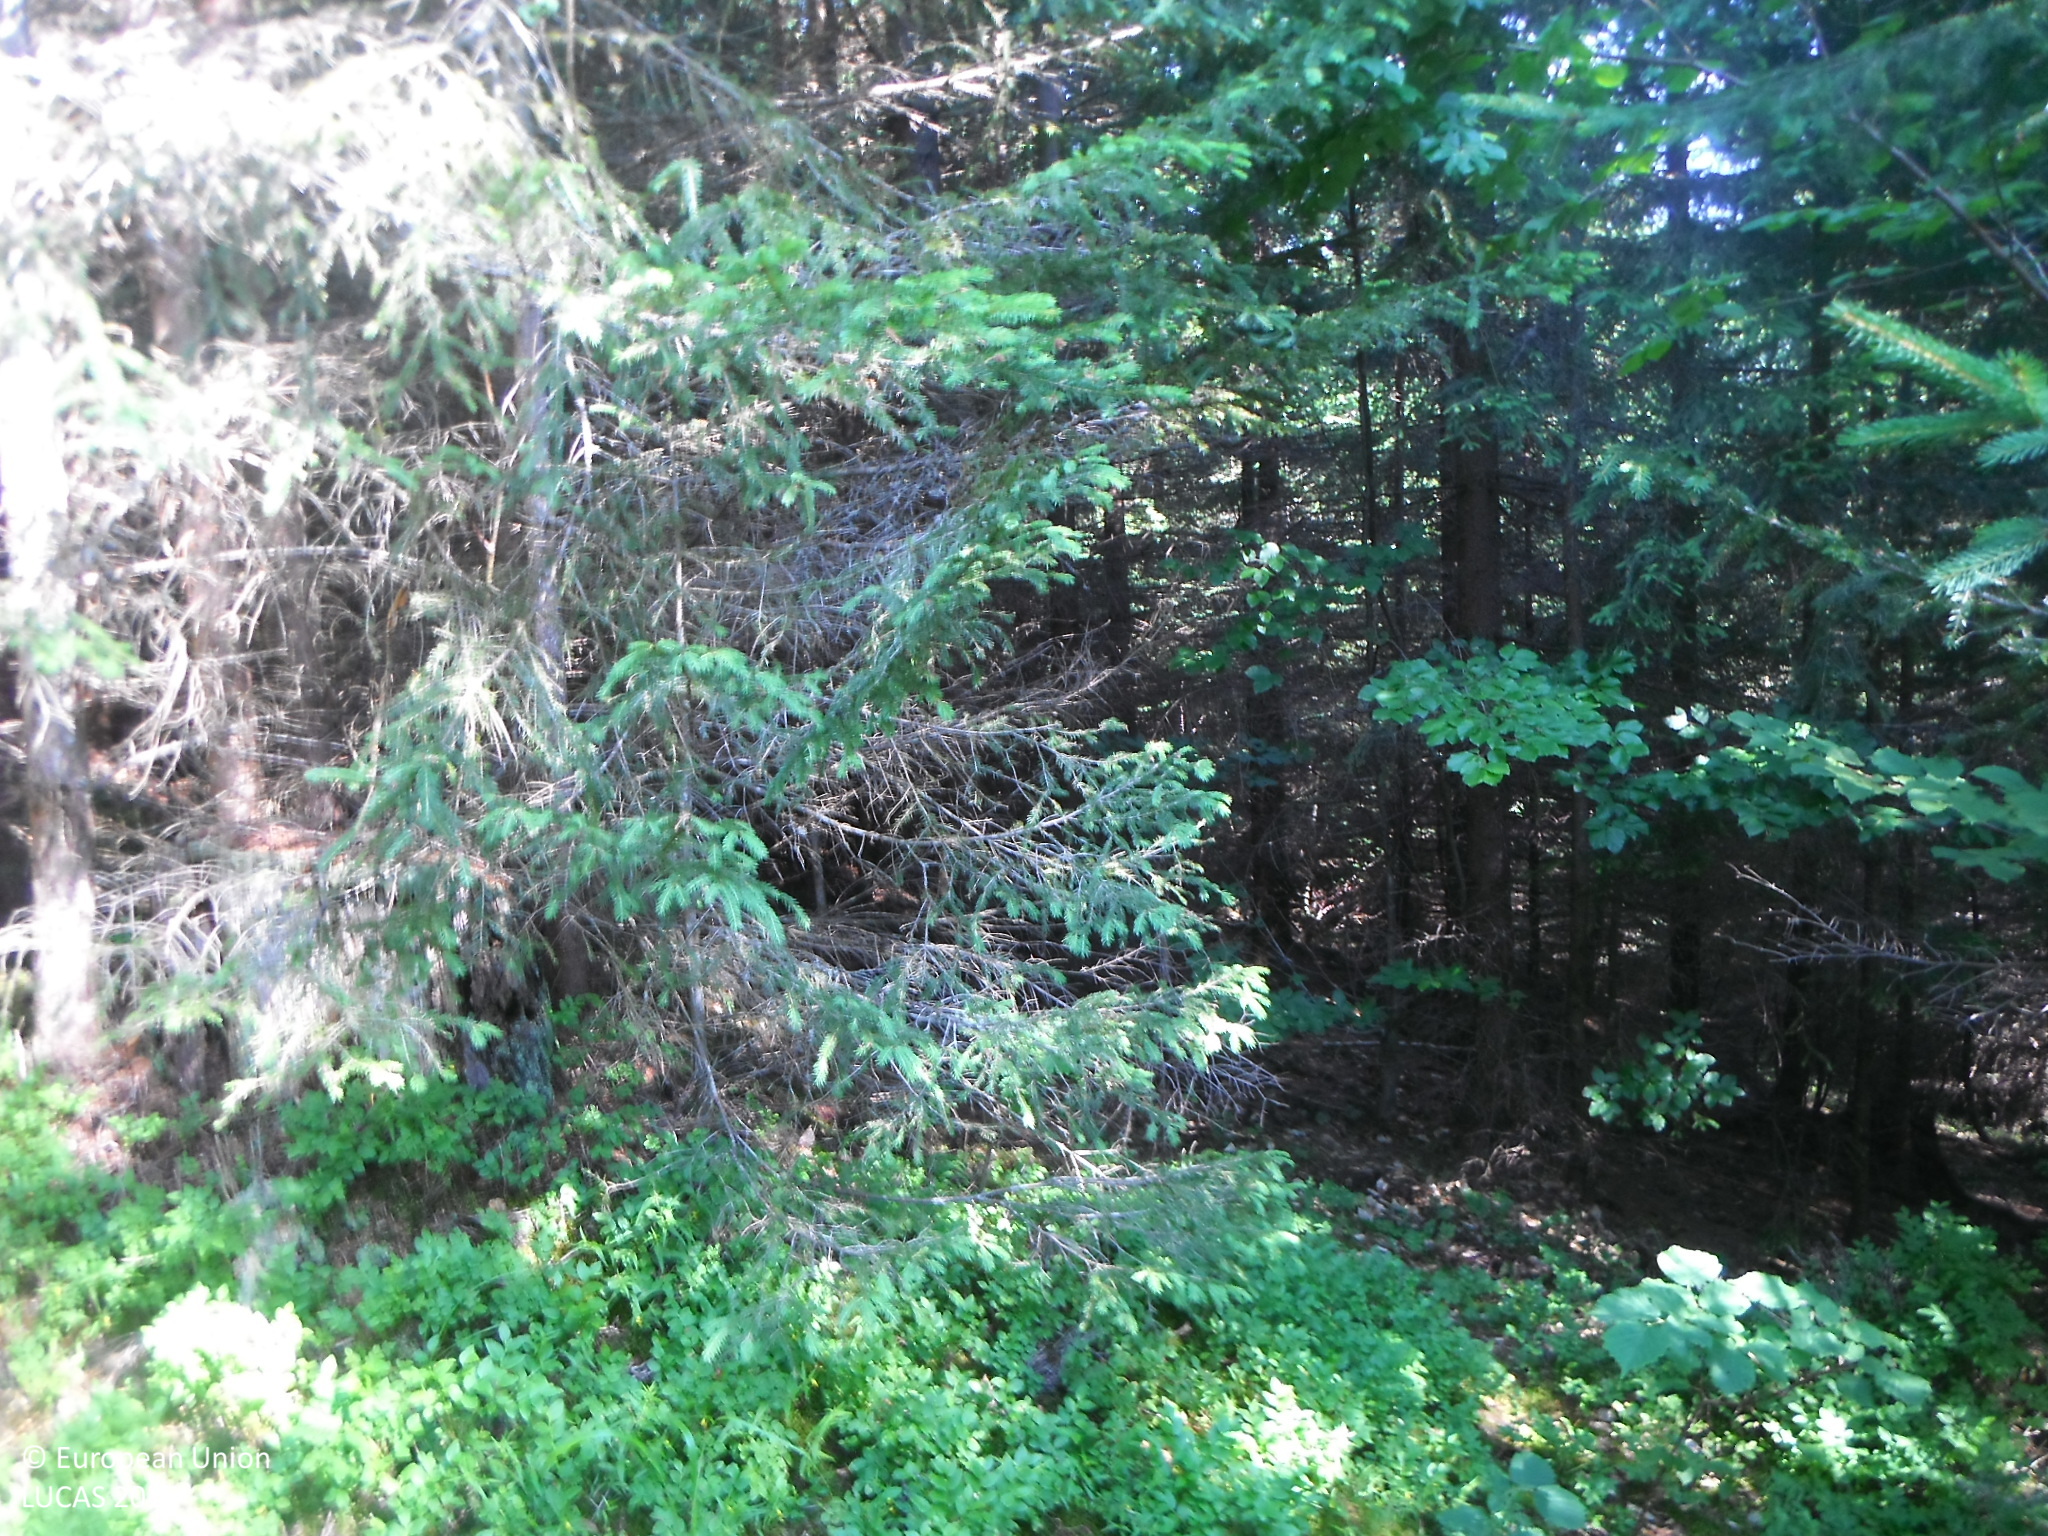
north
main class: Woodland
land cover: Spruce dominated mixed woodland
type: hemiboreal forest and nemoral coniferous forest and mixed broadleaved-coniferous forest
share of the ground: > 75 %
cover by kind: coniferous forest trees 60 %, broadleaved forest trees 40 %
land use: Forestry
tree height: > 5 m
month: July
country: SK
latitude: 48.9228
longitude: 20.2554
